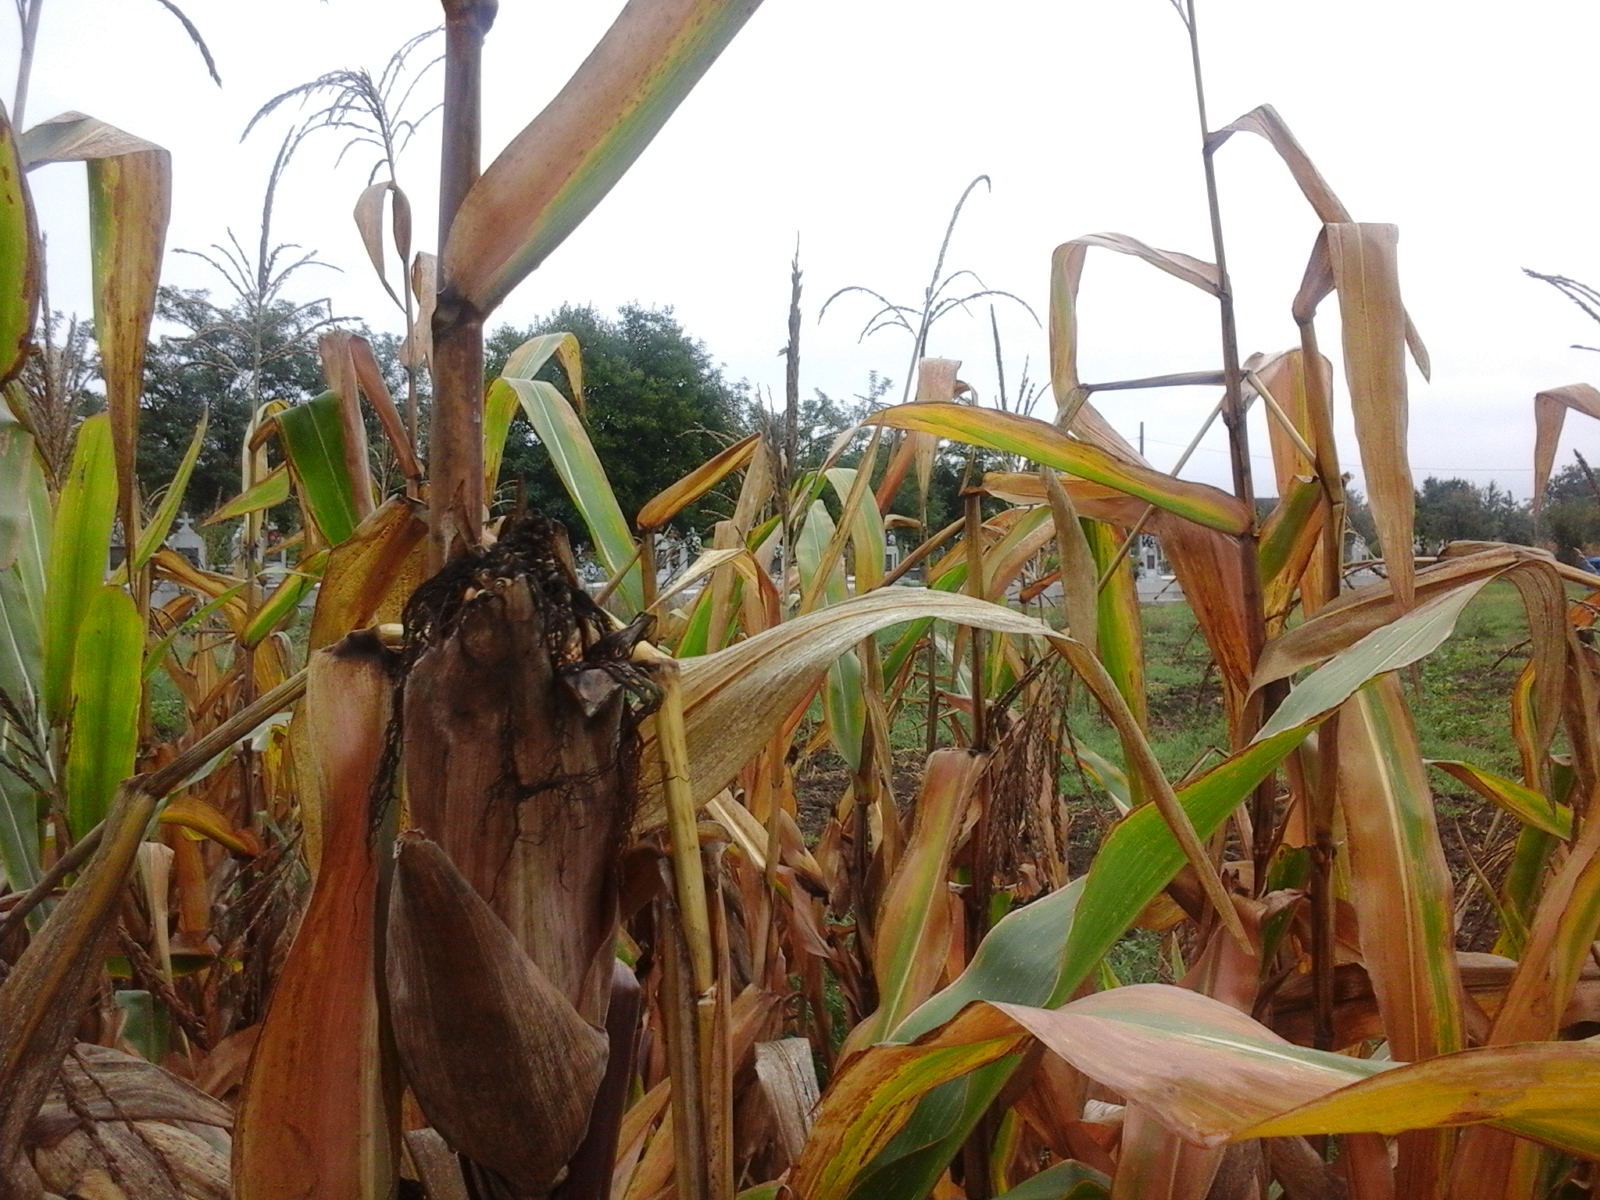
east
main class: Cropland
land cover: Maize
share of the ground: > 75 %
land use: Agriculture (excluding fallow land and kitchen gardens)
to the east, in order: Maize; Tracks; Artificial constructions in urban areas; Permanent crops (only in case pi); Maize; Abandoned hedges; Grassland without tree/shrub cover; Tracks; Artificial constructions in urban areas; Maize; Lucerne
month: September
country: RO
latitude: 47.0356
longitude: 21.6895
